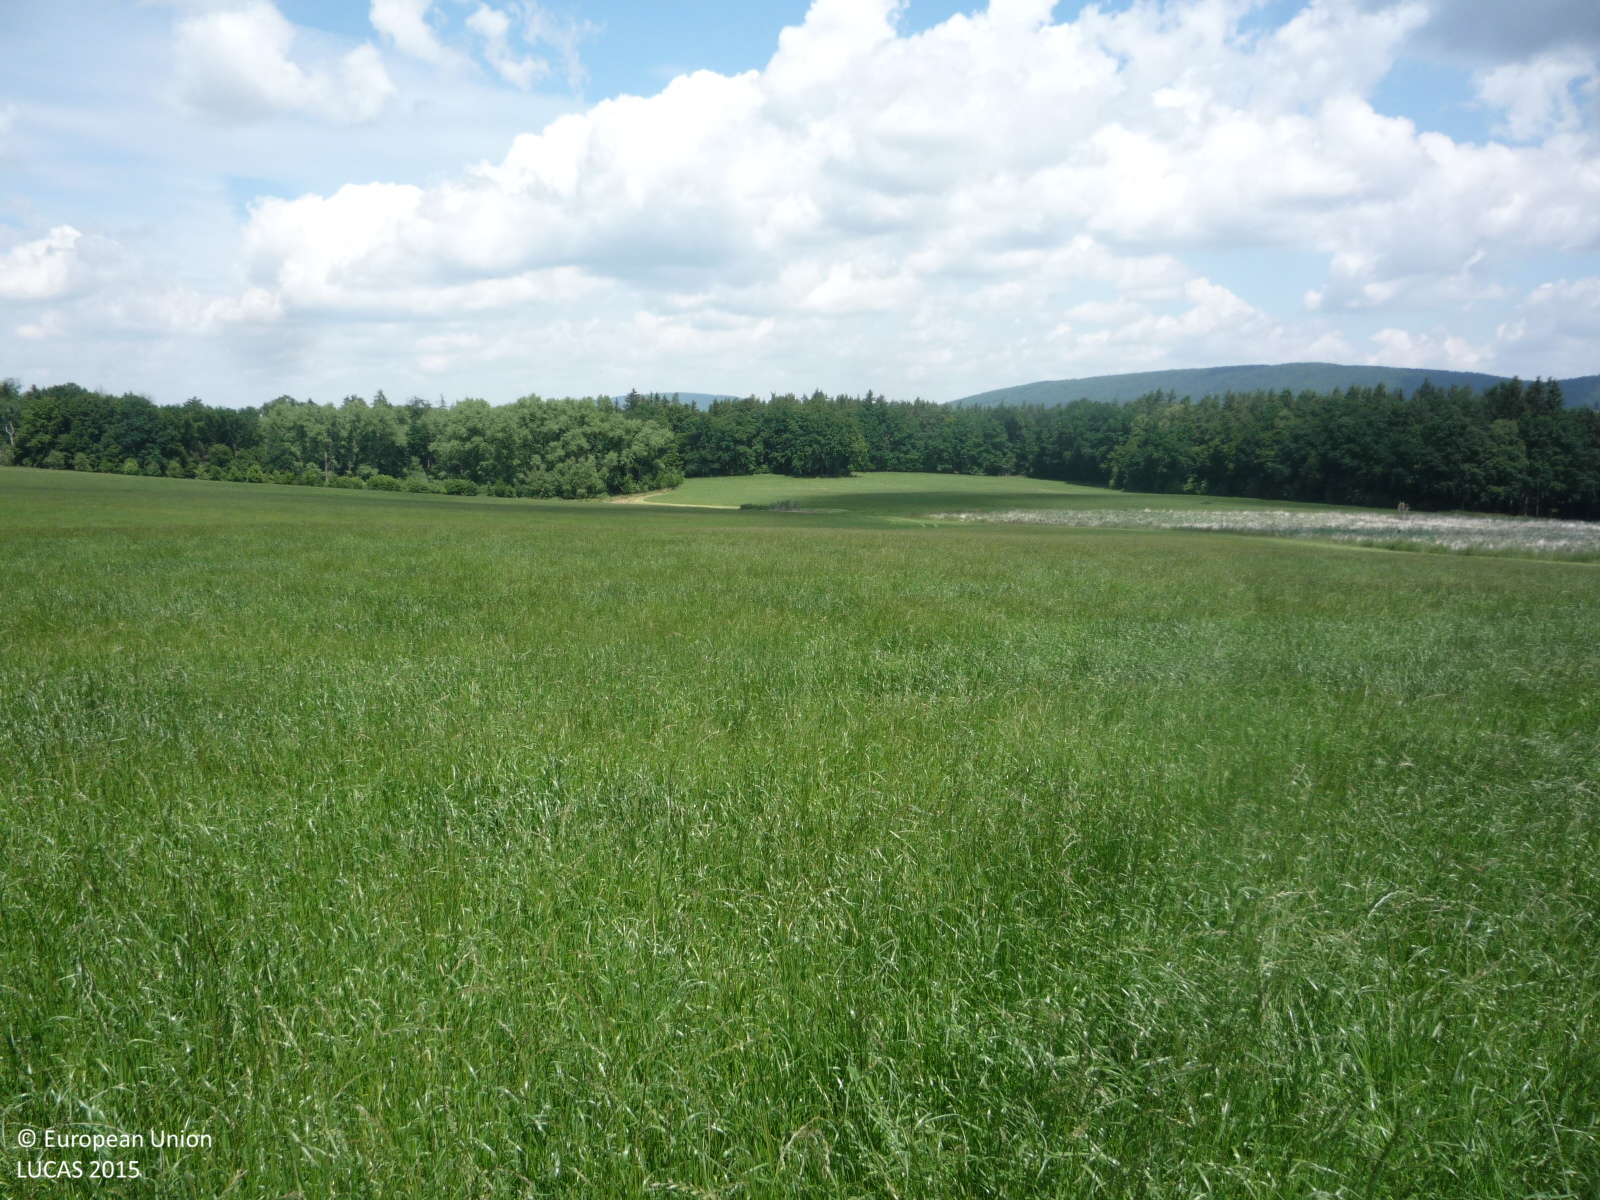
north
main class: Grassland
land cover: Grassland without tree/shrub cover
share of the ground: > 75 %
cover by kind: herbaceous plants 100 %
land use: Agriculture (excluding fallow land and kitchen gardens)
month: June
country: CZ
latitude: 49.8135
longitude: 15.5769
